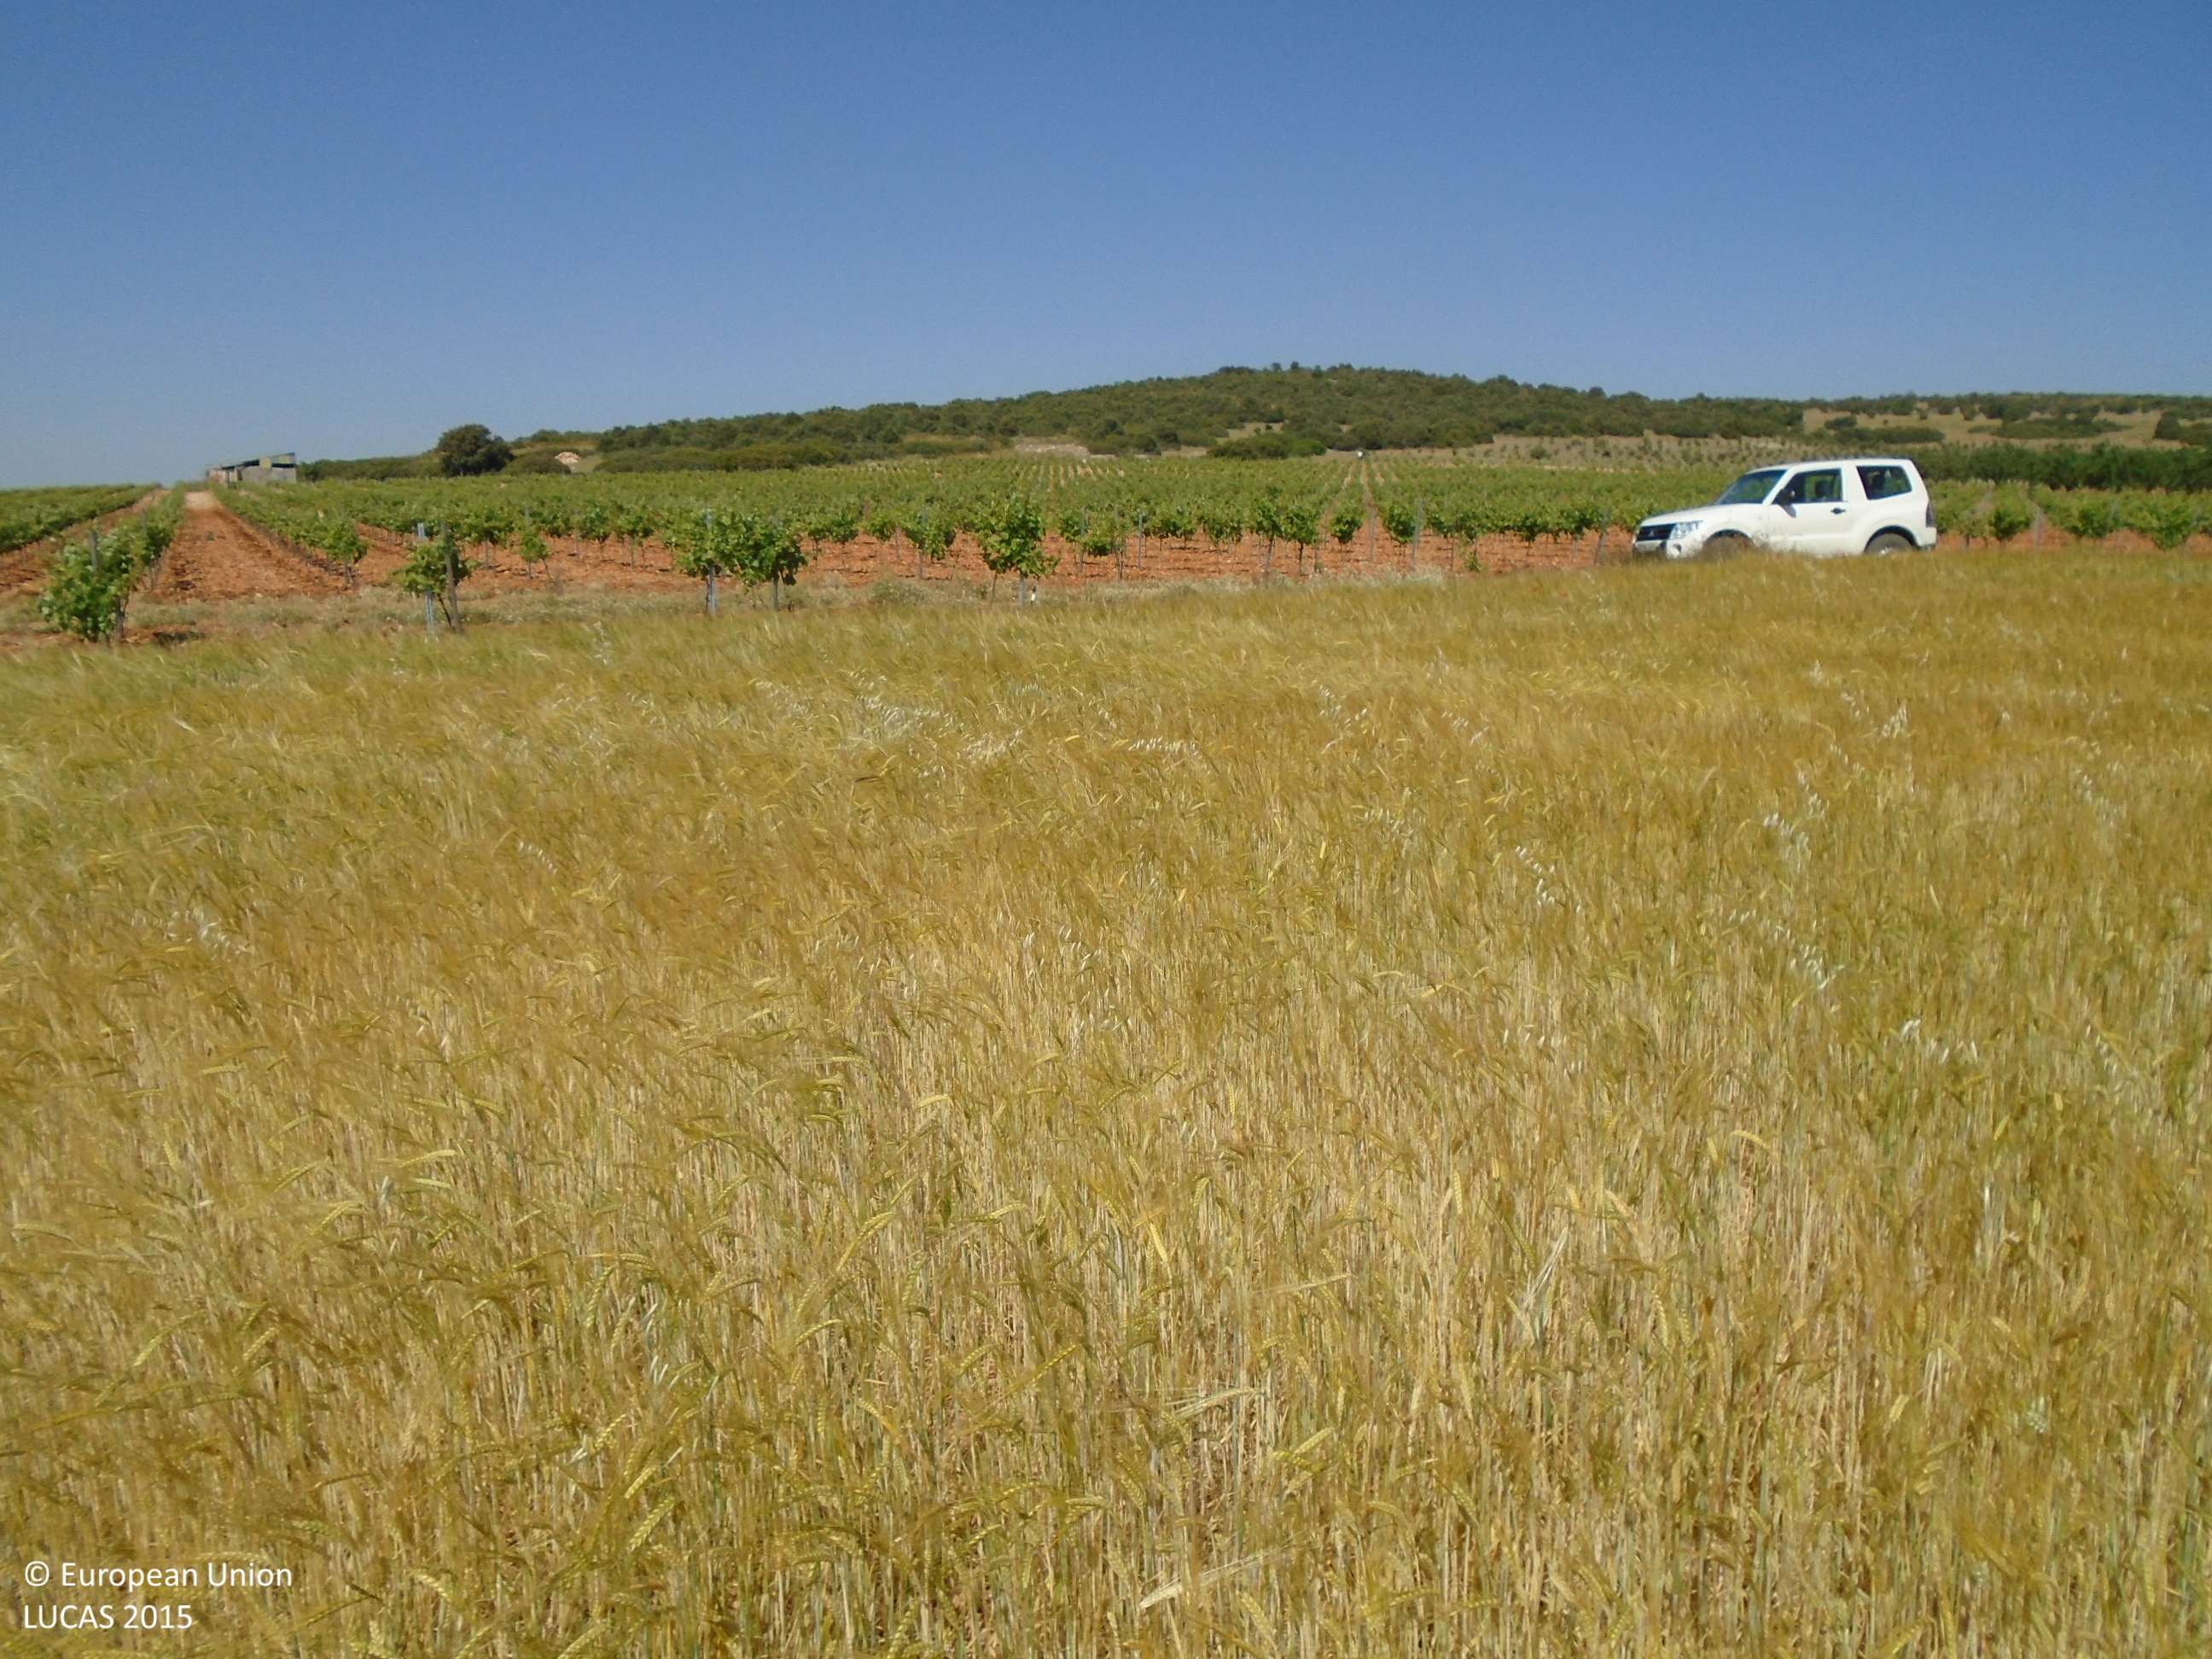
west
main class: Cropland
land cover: Barley
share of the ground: > 75 %
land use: Agriculture (excluding fallow land and kitchen gardens)
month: May
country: ES
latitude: 39.5511
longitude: -3.7470
